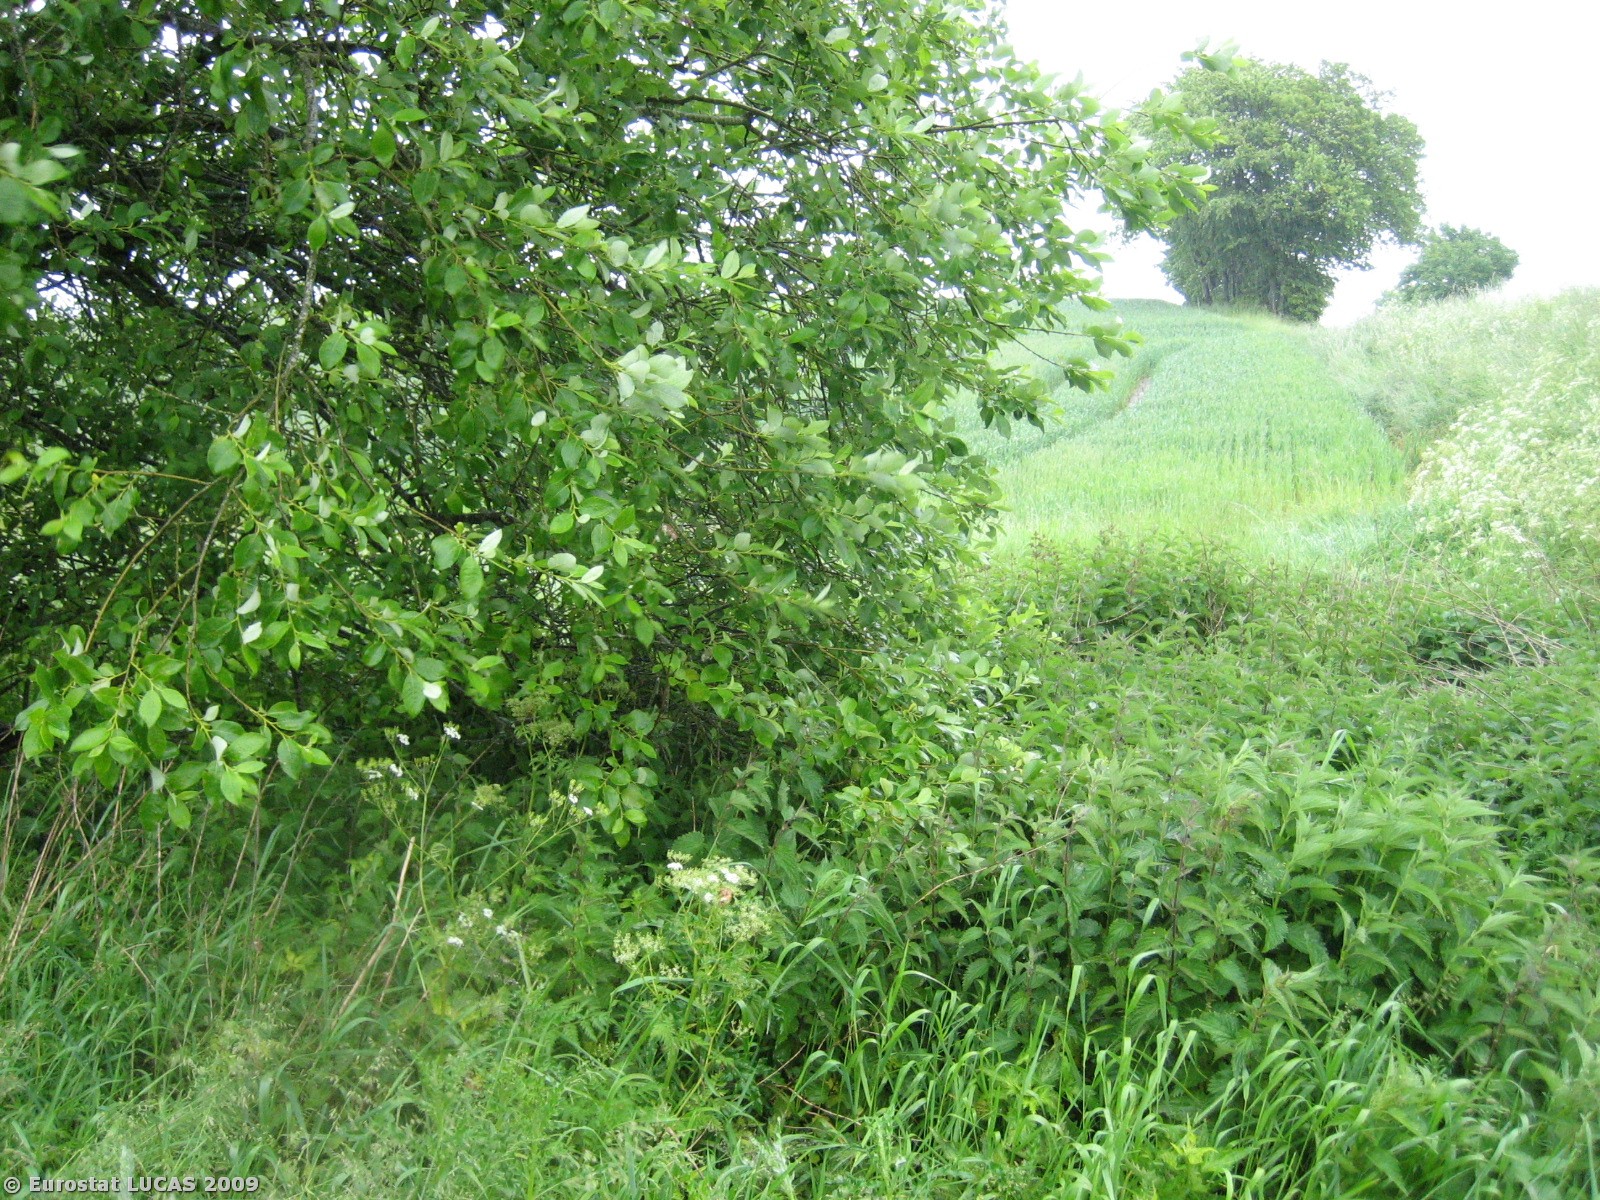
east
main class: Cropland
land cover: Common wheat
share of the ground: > 75 %
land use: Agriculture (excluding fallow land and kitchen gardens)
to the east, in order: Common wheat; Broadleaved woodland; Common wheat; Tracks
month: June
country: DK
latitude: 56.0079
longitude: 10.1442
